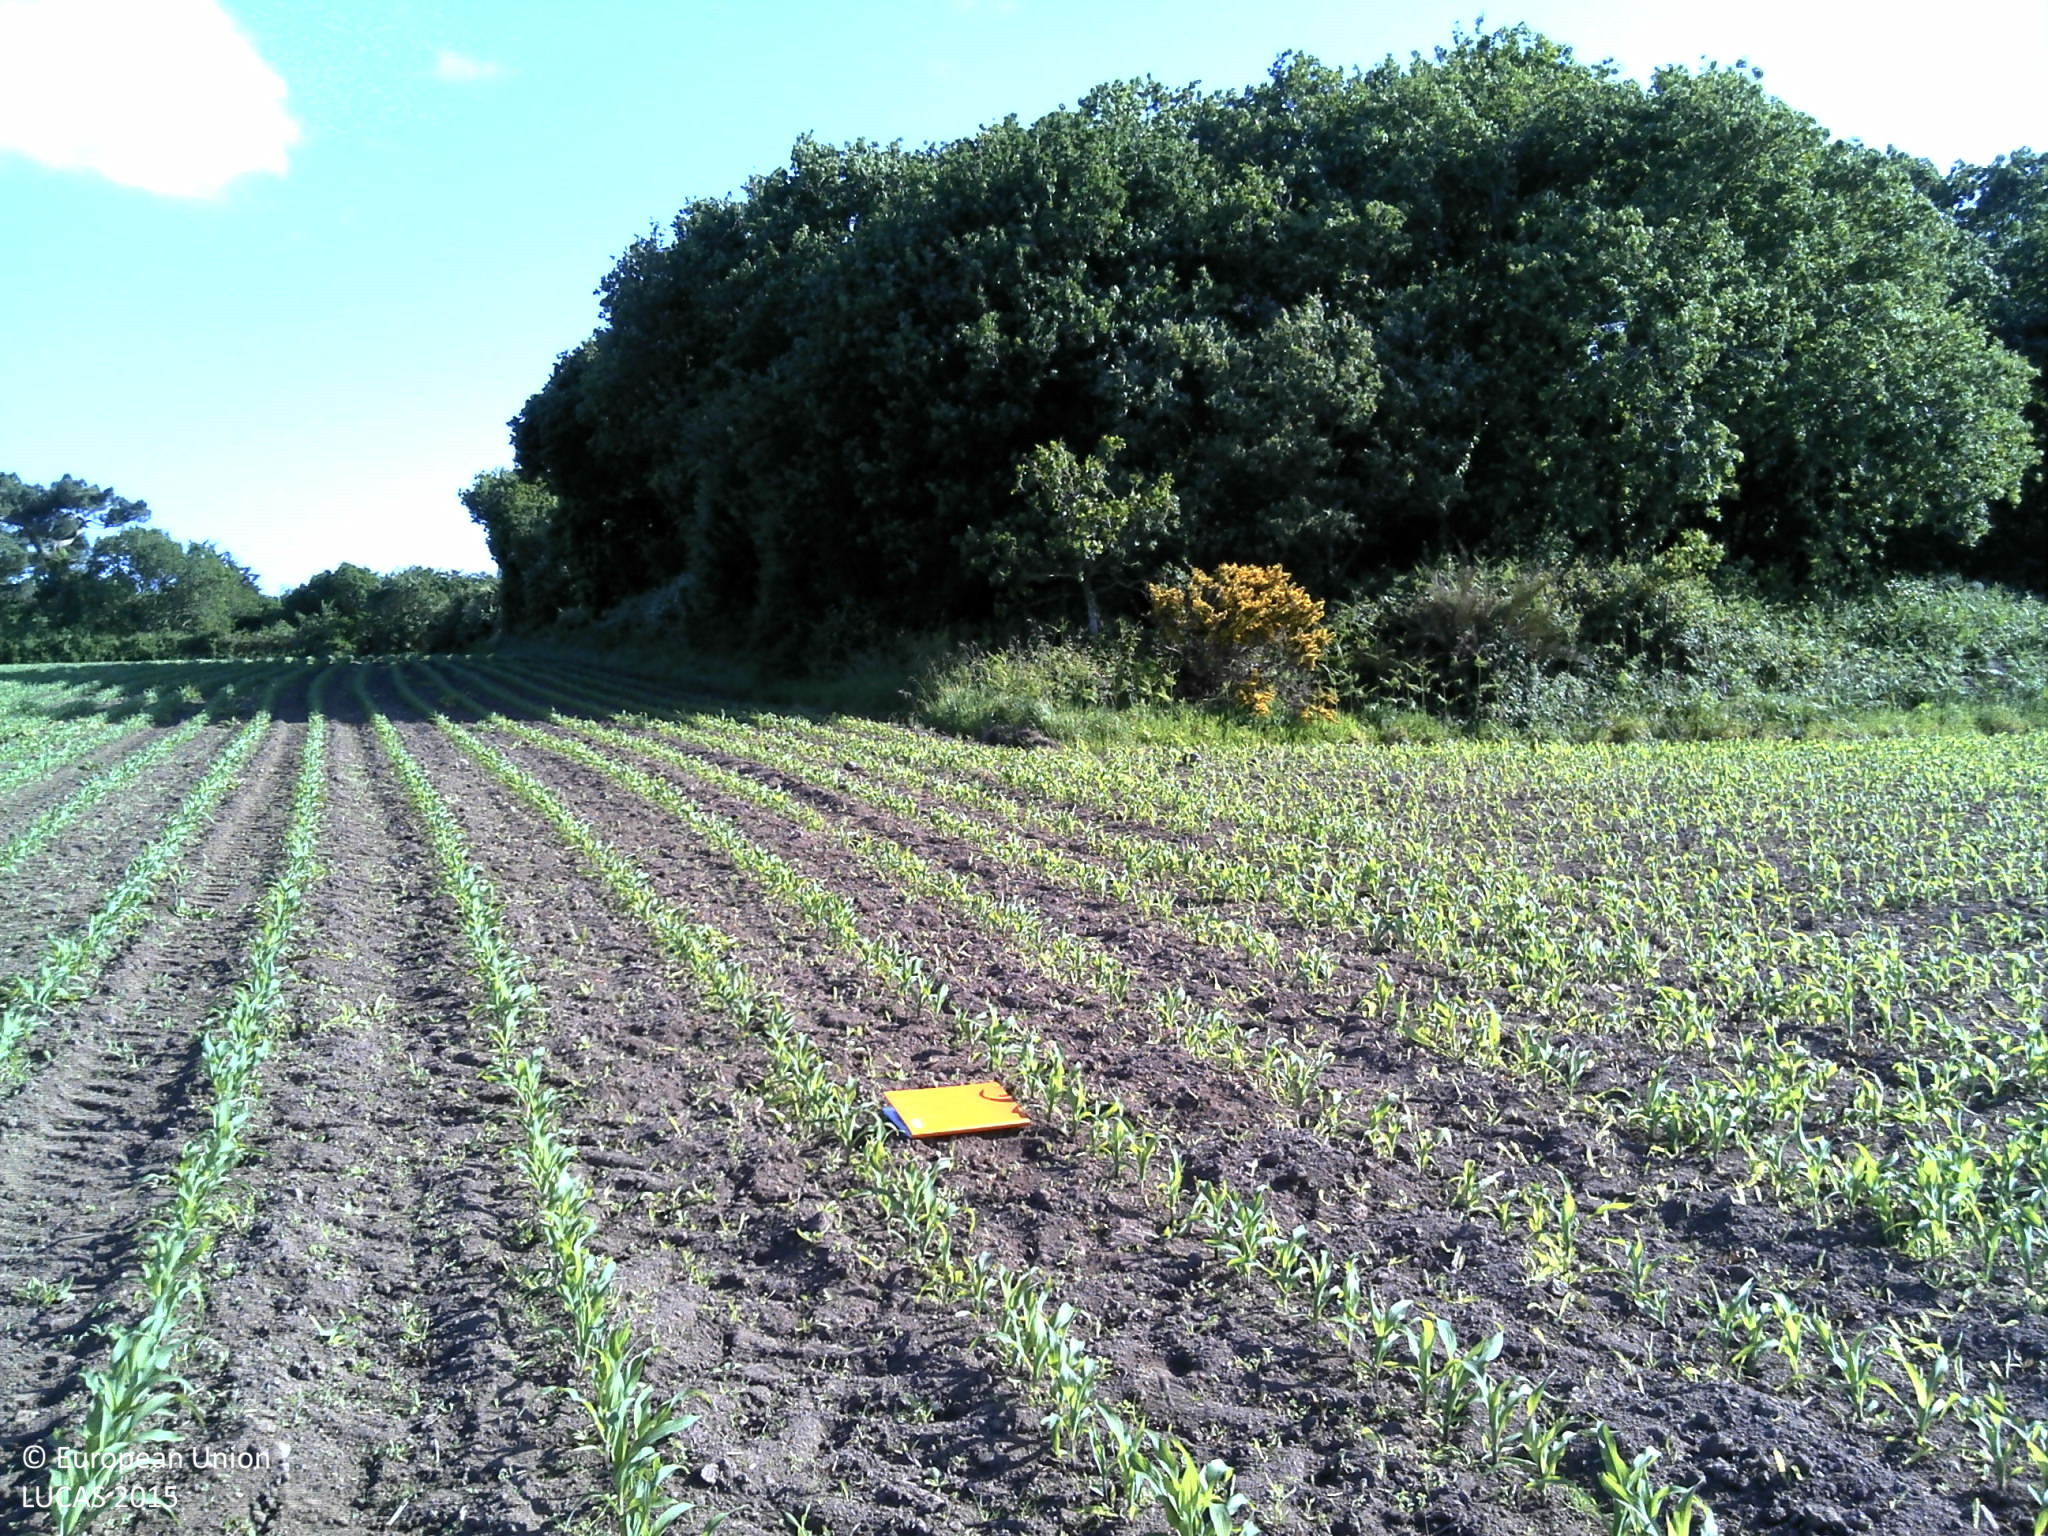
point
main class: Cropland
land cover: Maize
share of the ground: 50 - 75 %
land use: Agriculture (excluding fallow land and kitchen gardens)
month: June
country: FR
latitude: 48.0492
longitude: -4.4638
